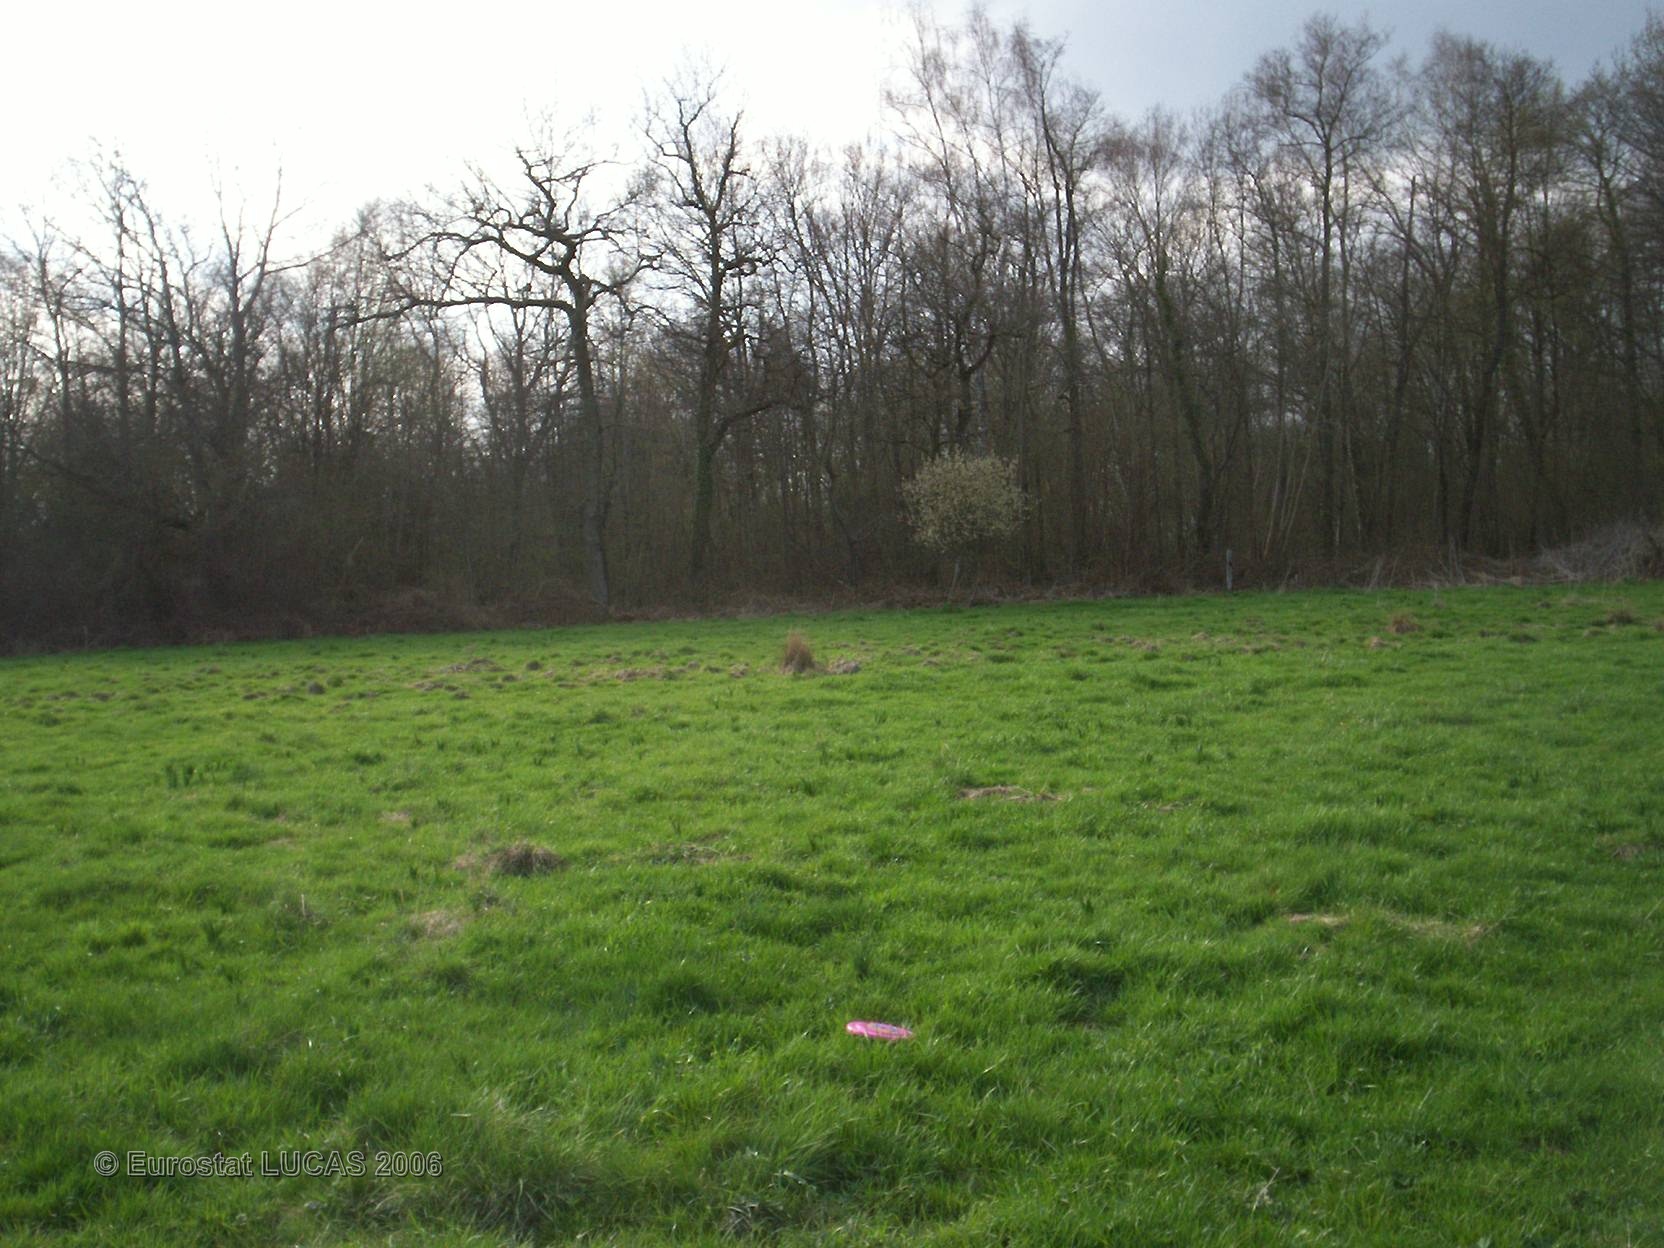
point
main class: Grassland
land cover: Grassland without tree/shrub cover
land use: Agriculture (excluding fallow land and kitchen gardens)
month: April
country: FR
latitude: 49.5177
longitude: 5.0387
